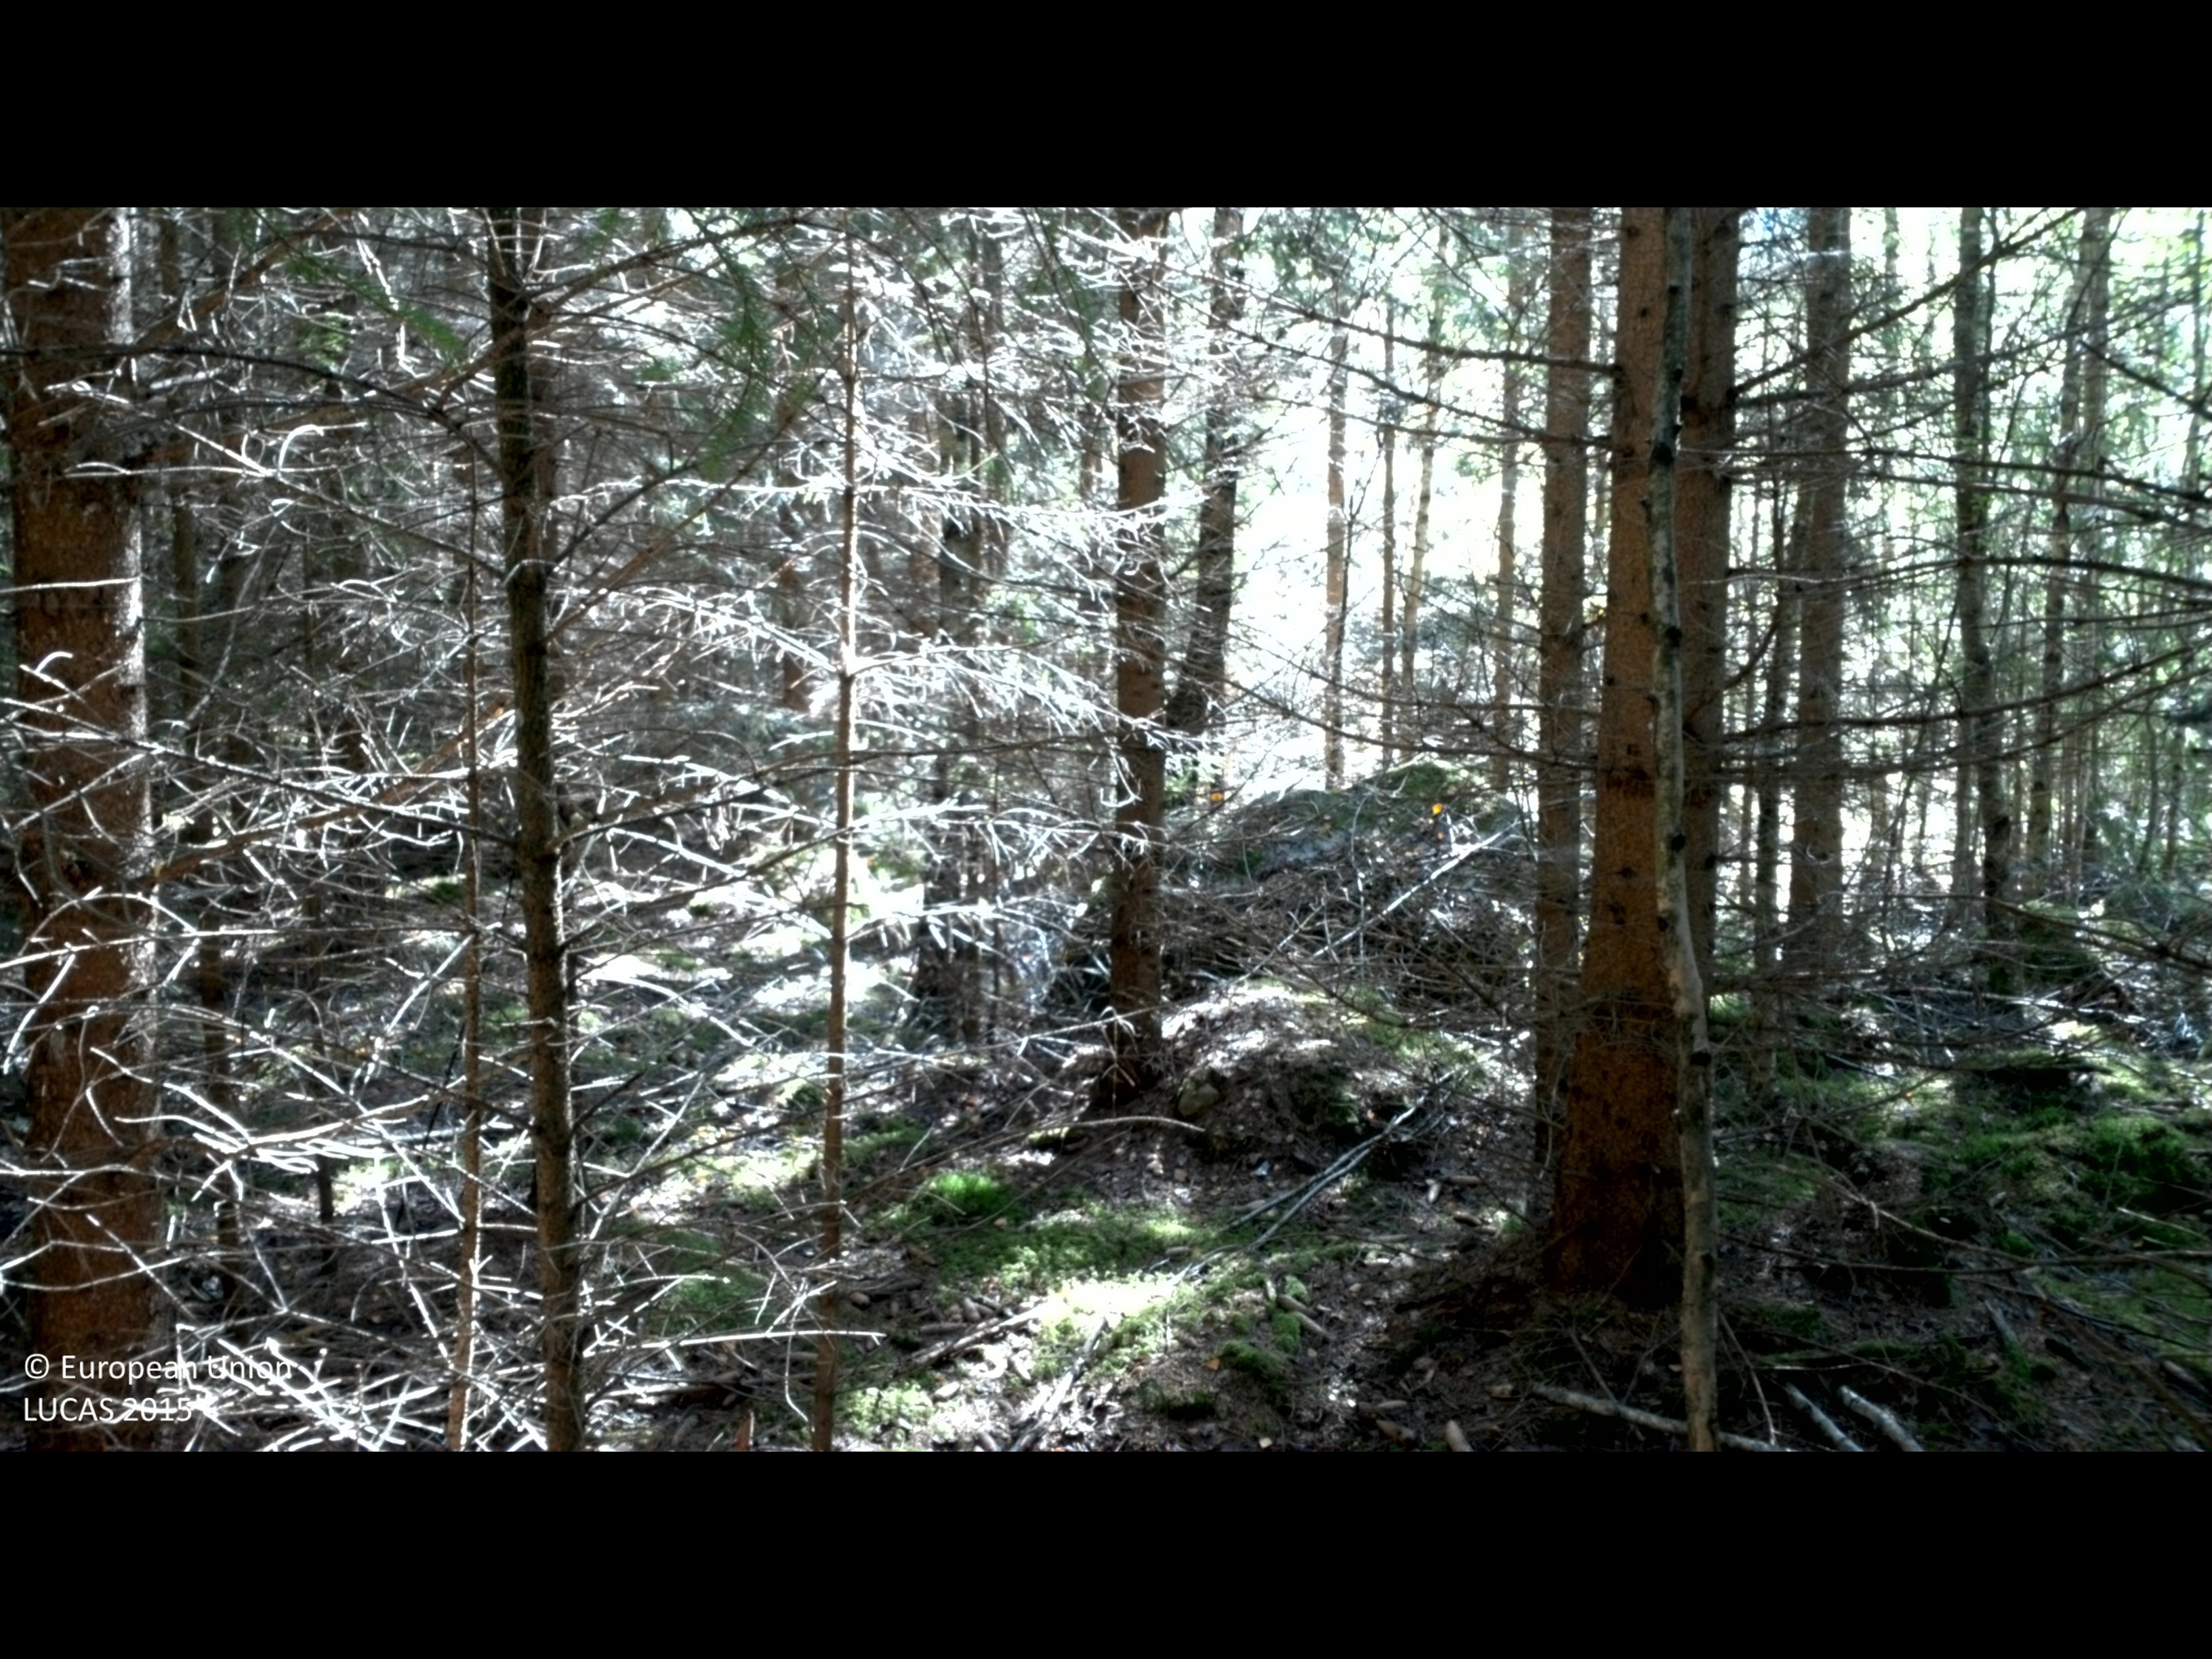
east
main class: Woodland
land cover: Spruce dominated coniferous woodland
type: boreal forest
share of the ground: > 75 %
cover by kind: coniferous forest trees 90 %, lichens and mosses 5 %, unconsolidated bare surface 5 %
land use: Forestry
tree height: > 5 m
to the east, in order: Spruce dominated coniferous woodland
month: August
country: SE
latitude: 56.3345
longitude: 14.7373
